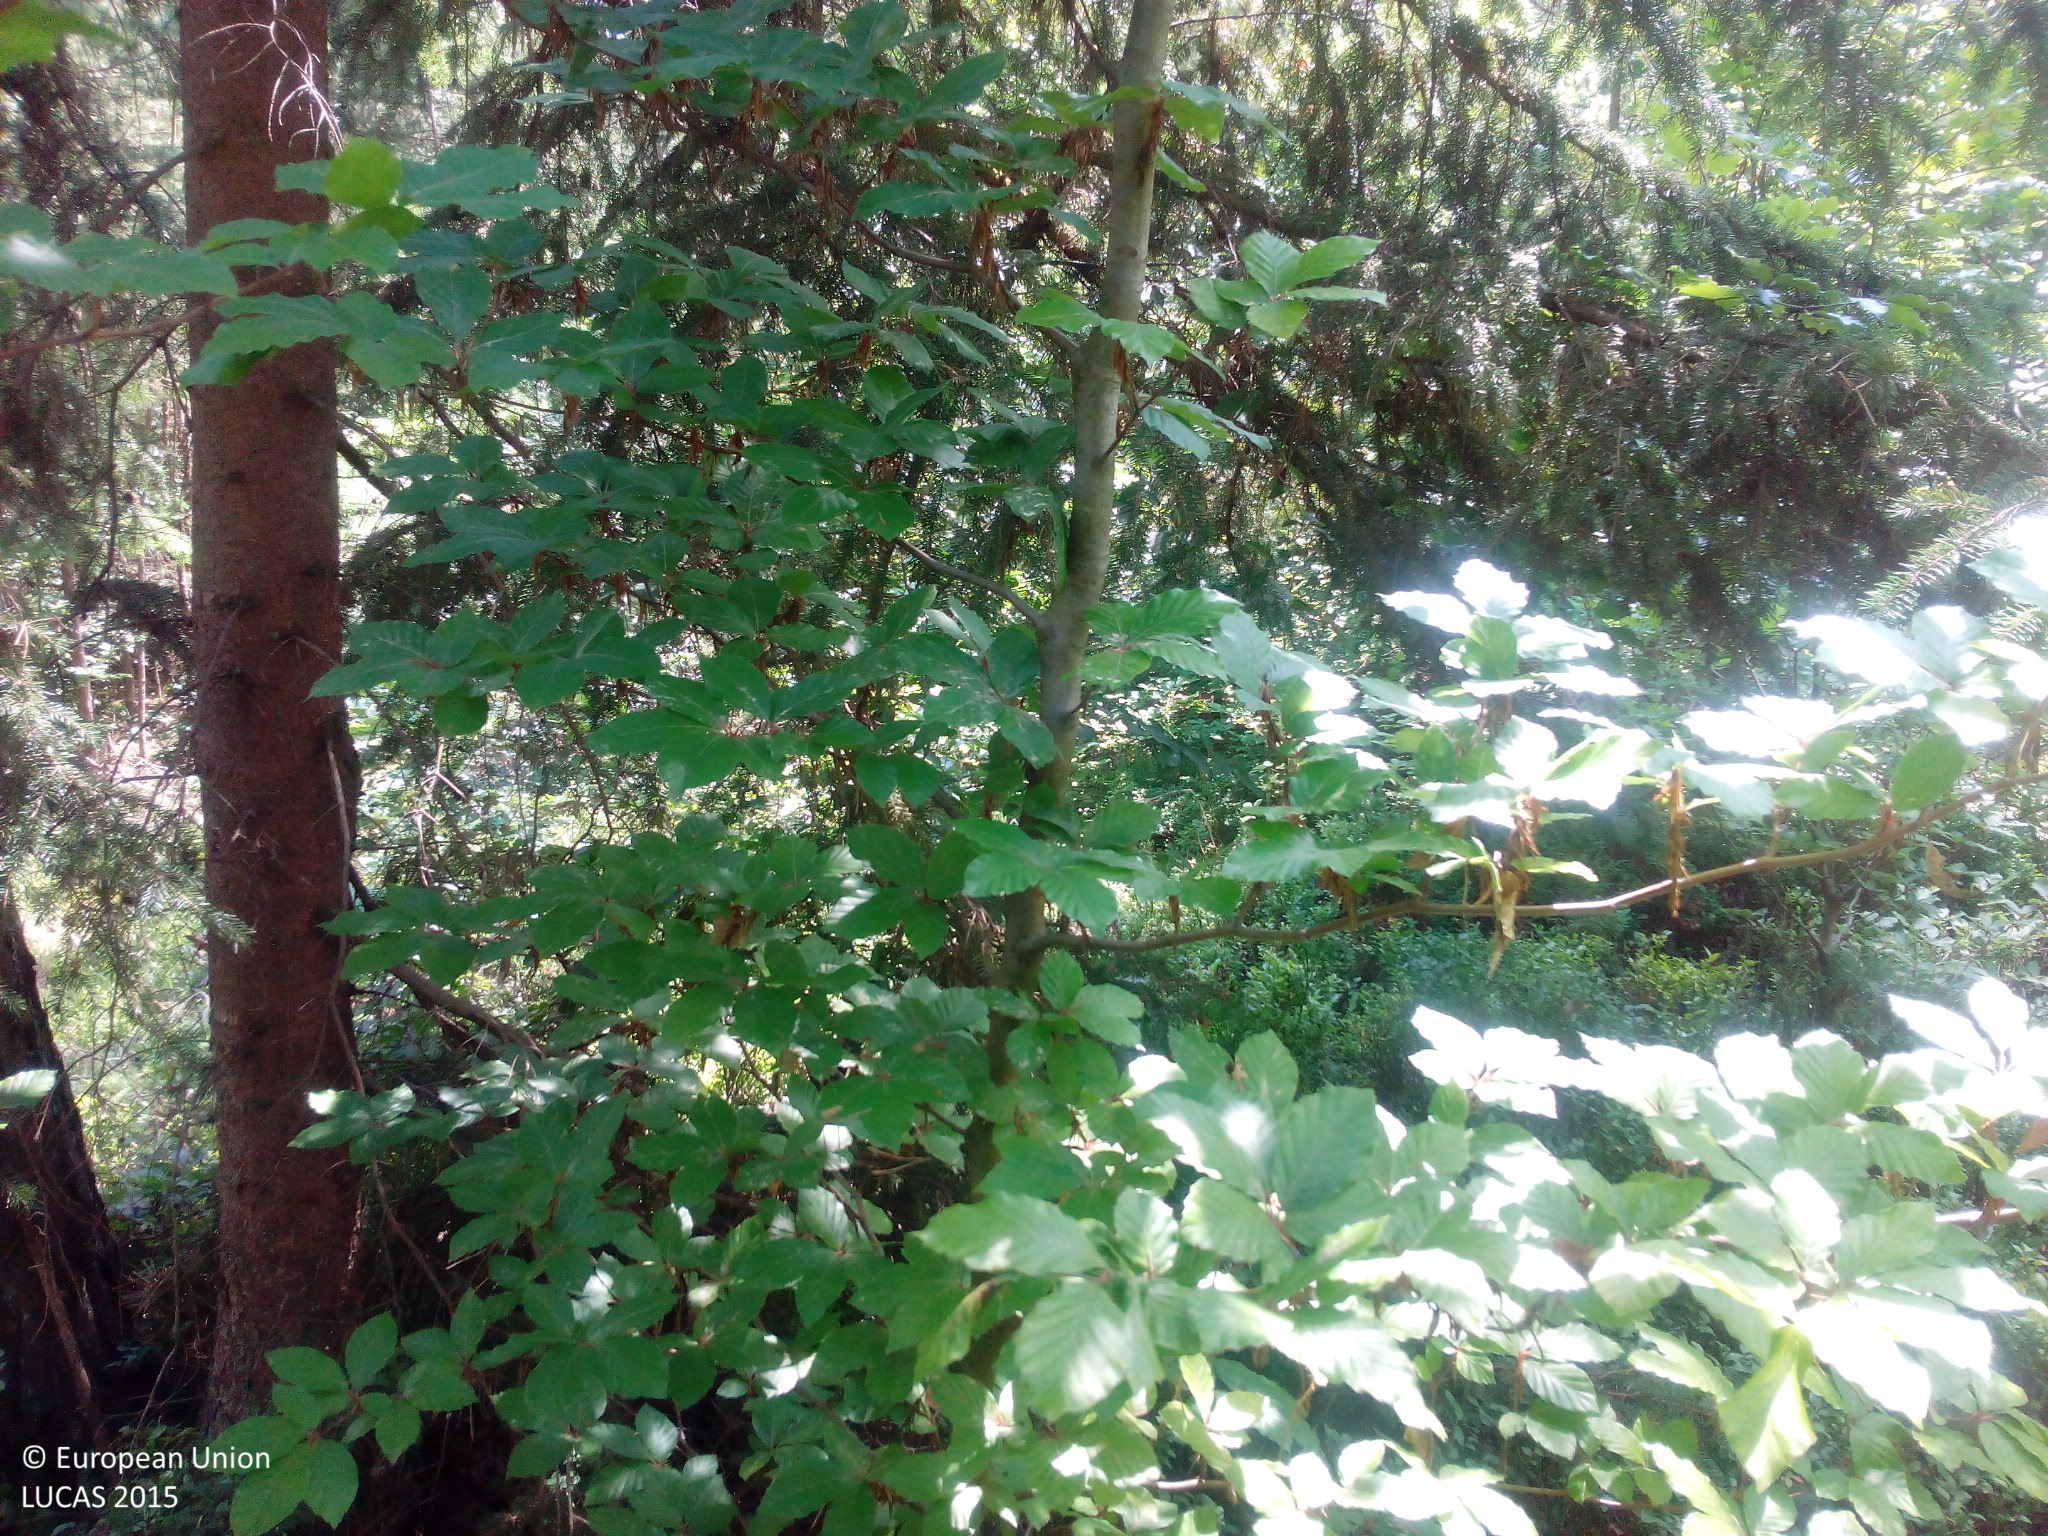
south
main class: Woodland
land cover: Pine dominated mixed woodland
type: hemiboreal forest and nemoral coniferous forest and mixed broadleaved-coniferous forest
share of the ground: > 75 %
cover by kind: coniferous forest trees 45 %, broadleaved forest trees 30 %, shrubs 20 %, lichens and mosses 5 %
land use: Forestry
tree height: > 5 m
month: July
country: DE
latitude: 49.6767
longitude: 10.9559
